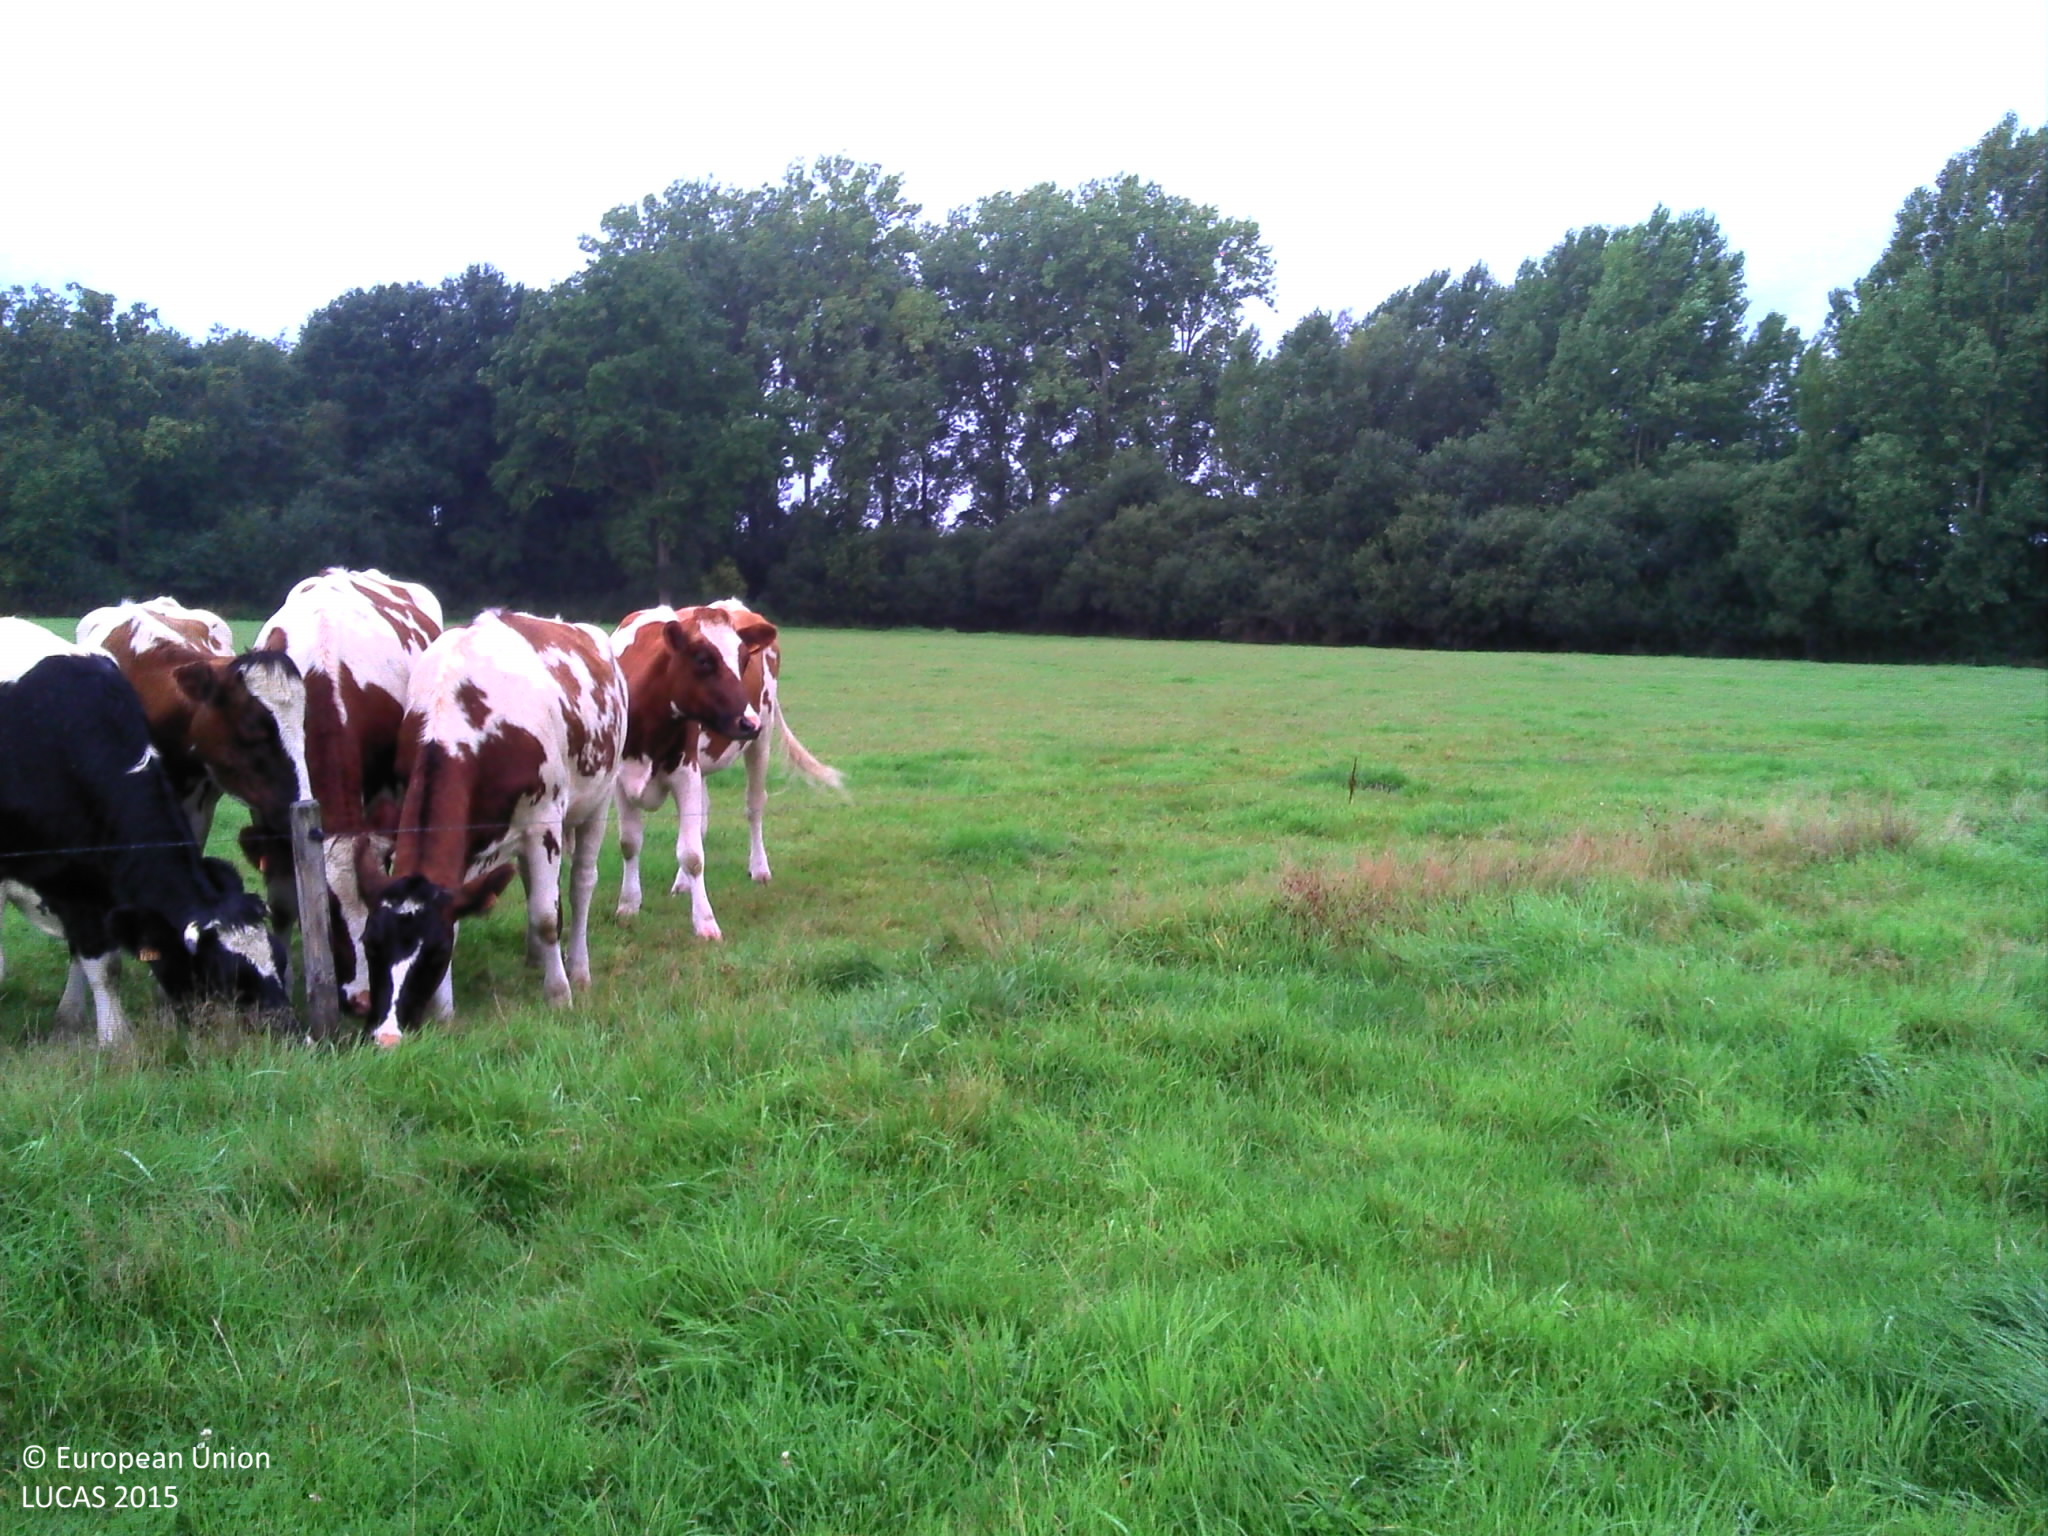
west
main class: Grassland
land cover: Grassland without tree/shrub cover
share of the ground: > 75 %
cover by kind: herbaceous plants 100 %
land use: Agriculture (excluding fallow land and kitchen gardens)
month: September
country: BE
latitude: 51.4312
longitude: 4.7175
